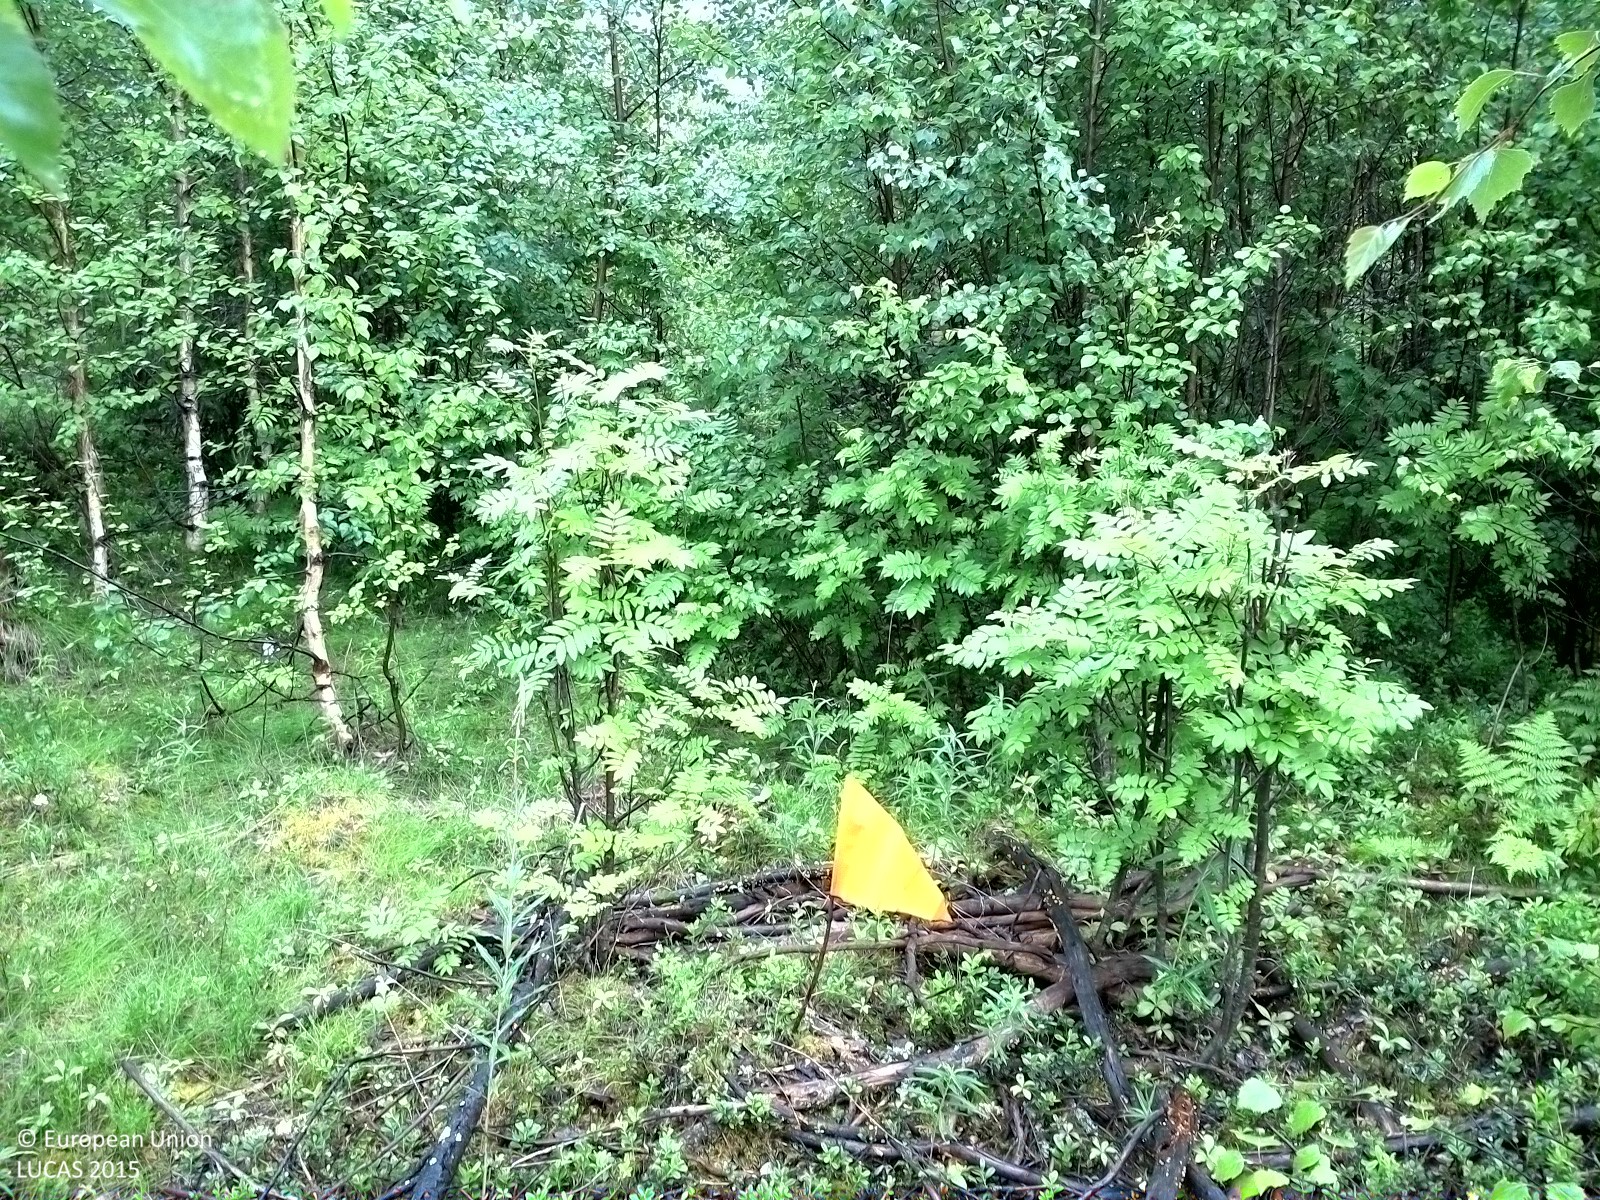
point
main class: Woodland
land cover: Broadleaved woodland
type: boreal forest
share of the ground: 50 - 75 %
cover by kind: herbaceous plants 45 %, broadleaved forest trees 40 %, coniferous forest trees 10 %, shrubs 5 %
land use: Forestry
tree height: < 5 m
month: July
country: SE
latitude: 62.6197
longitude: 17.6005
